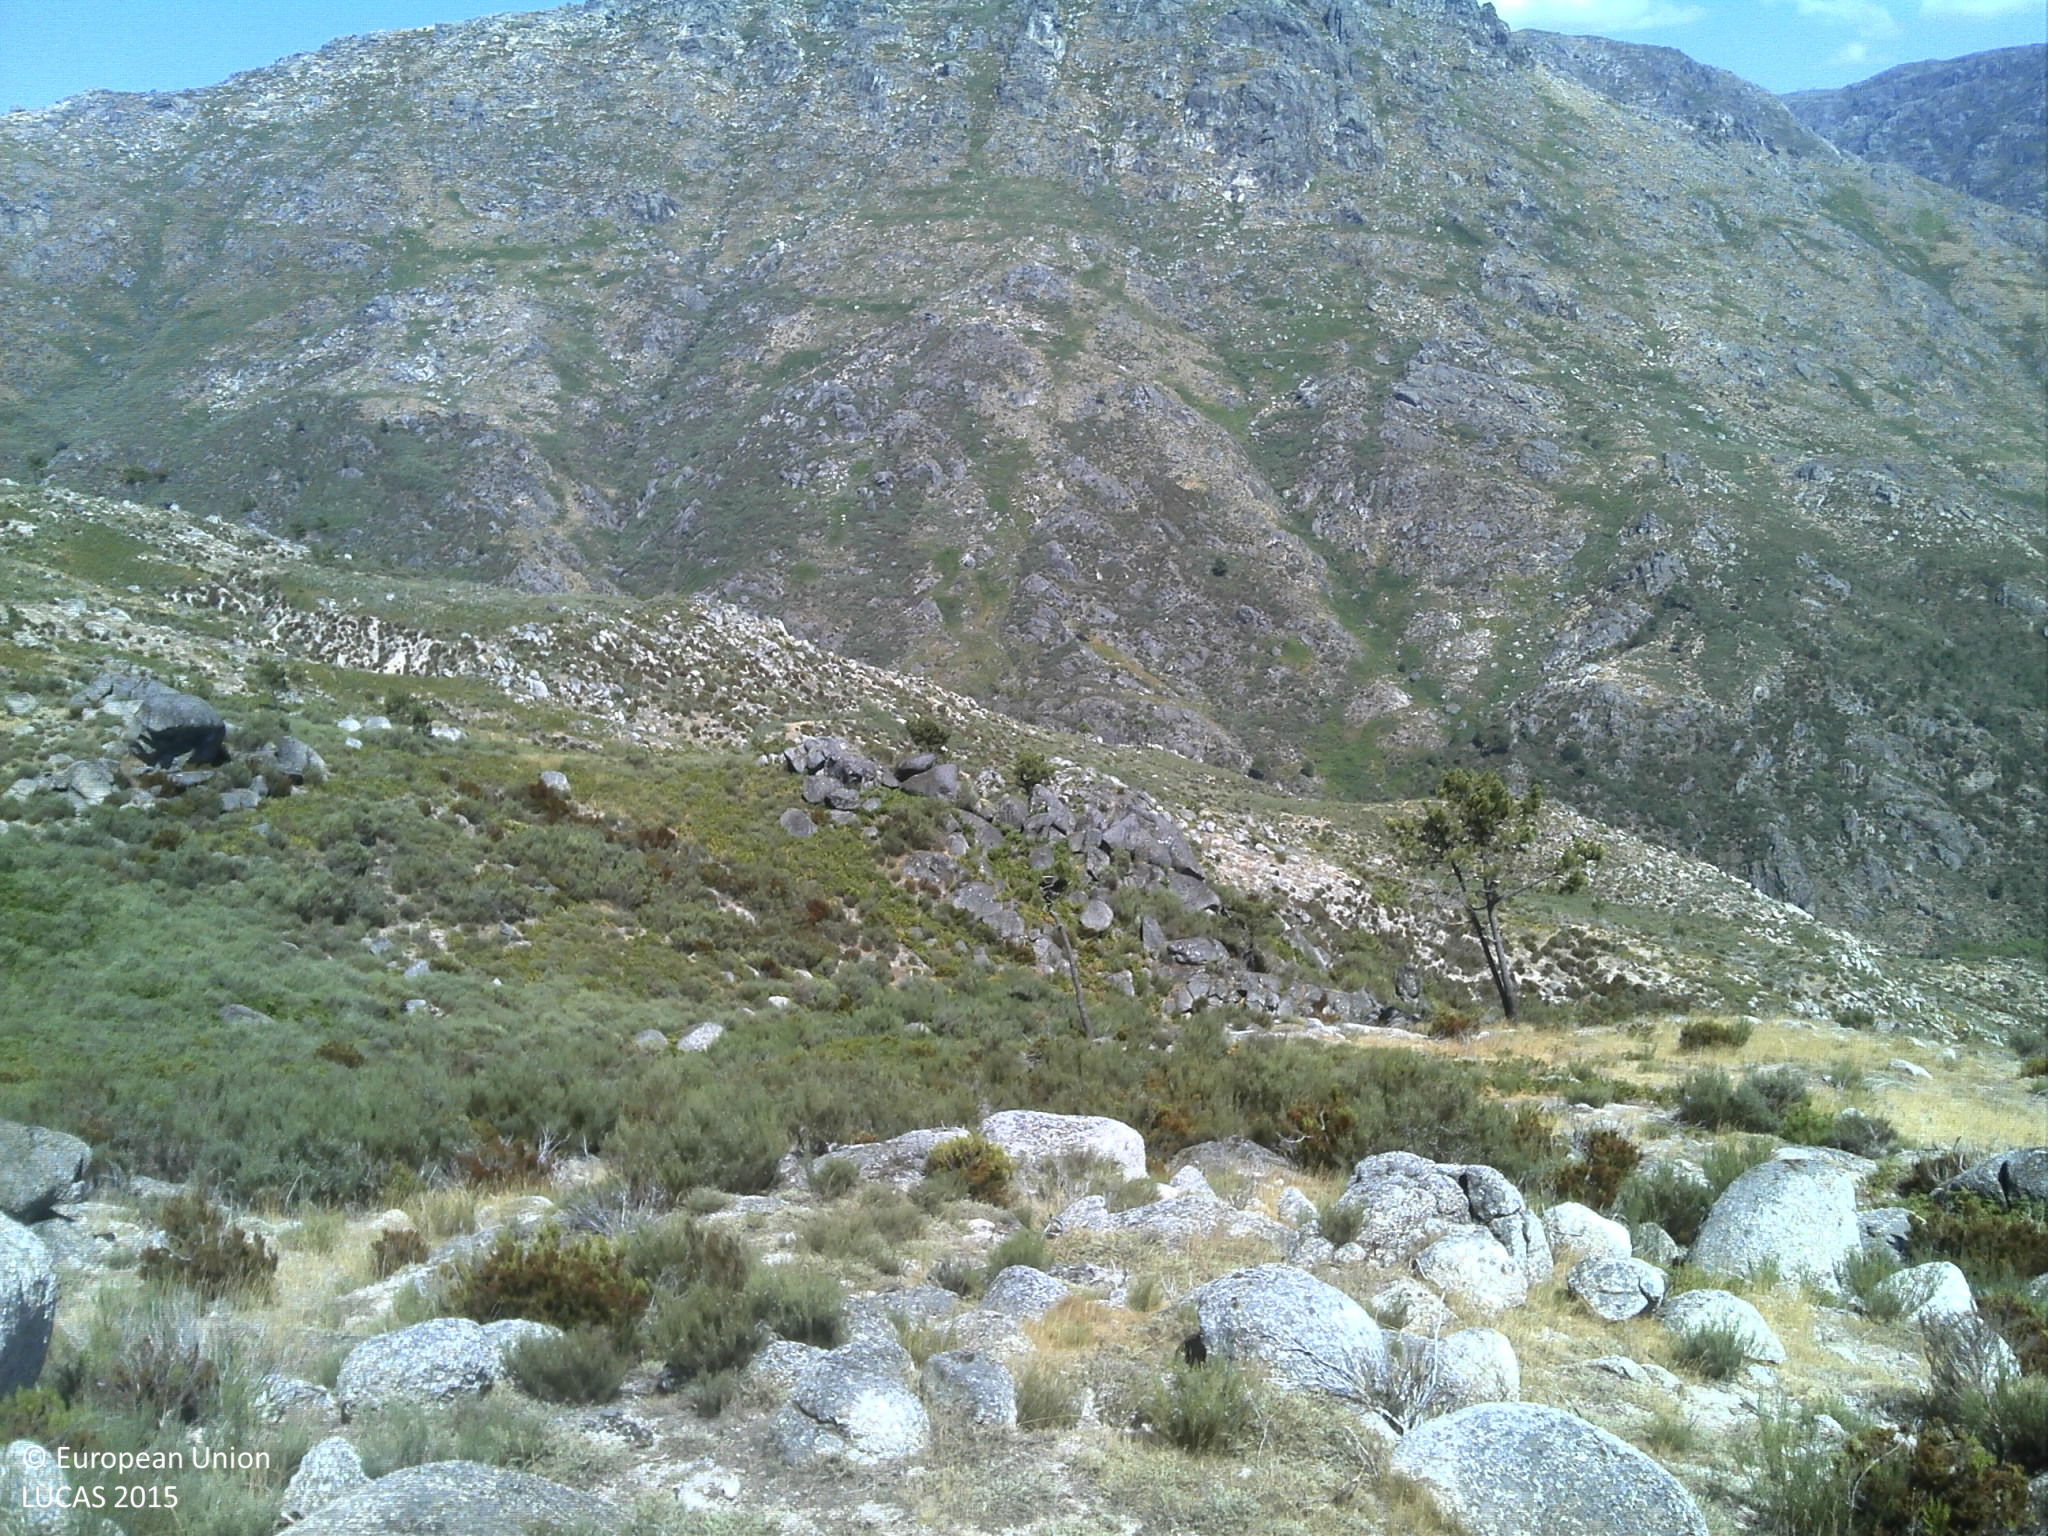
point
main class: Shrubland
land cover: Shrubland without tree cover
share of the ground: 50 - 75 %
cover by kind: shrubs 60 %, unconsolidated bare surface 30 %, herbaceous plants 10 %
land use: Semi-natural and natural areas not in use
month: July
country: PT
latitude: 40.3442
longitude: -7.6896
